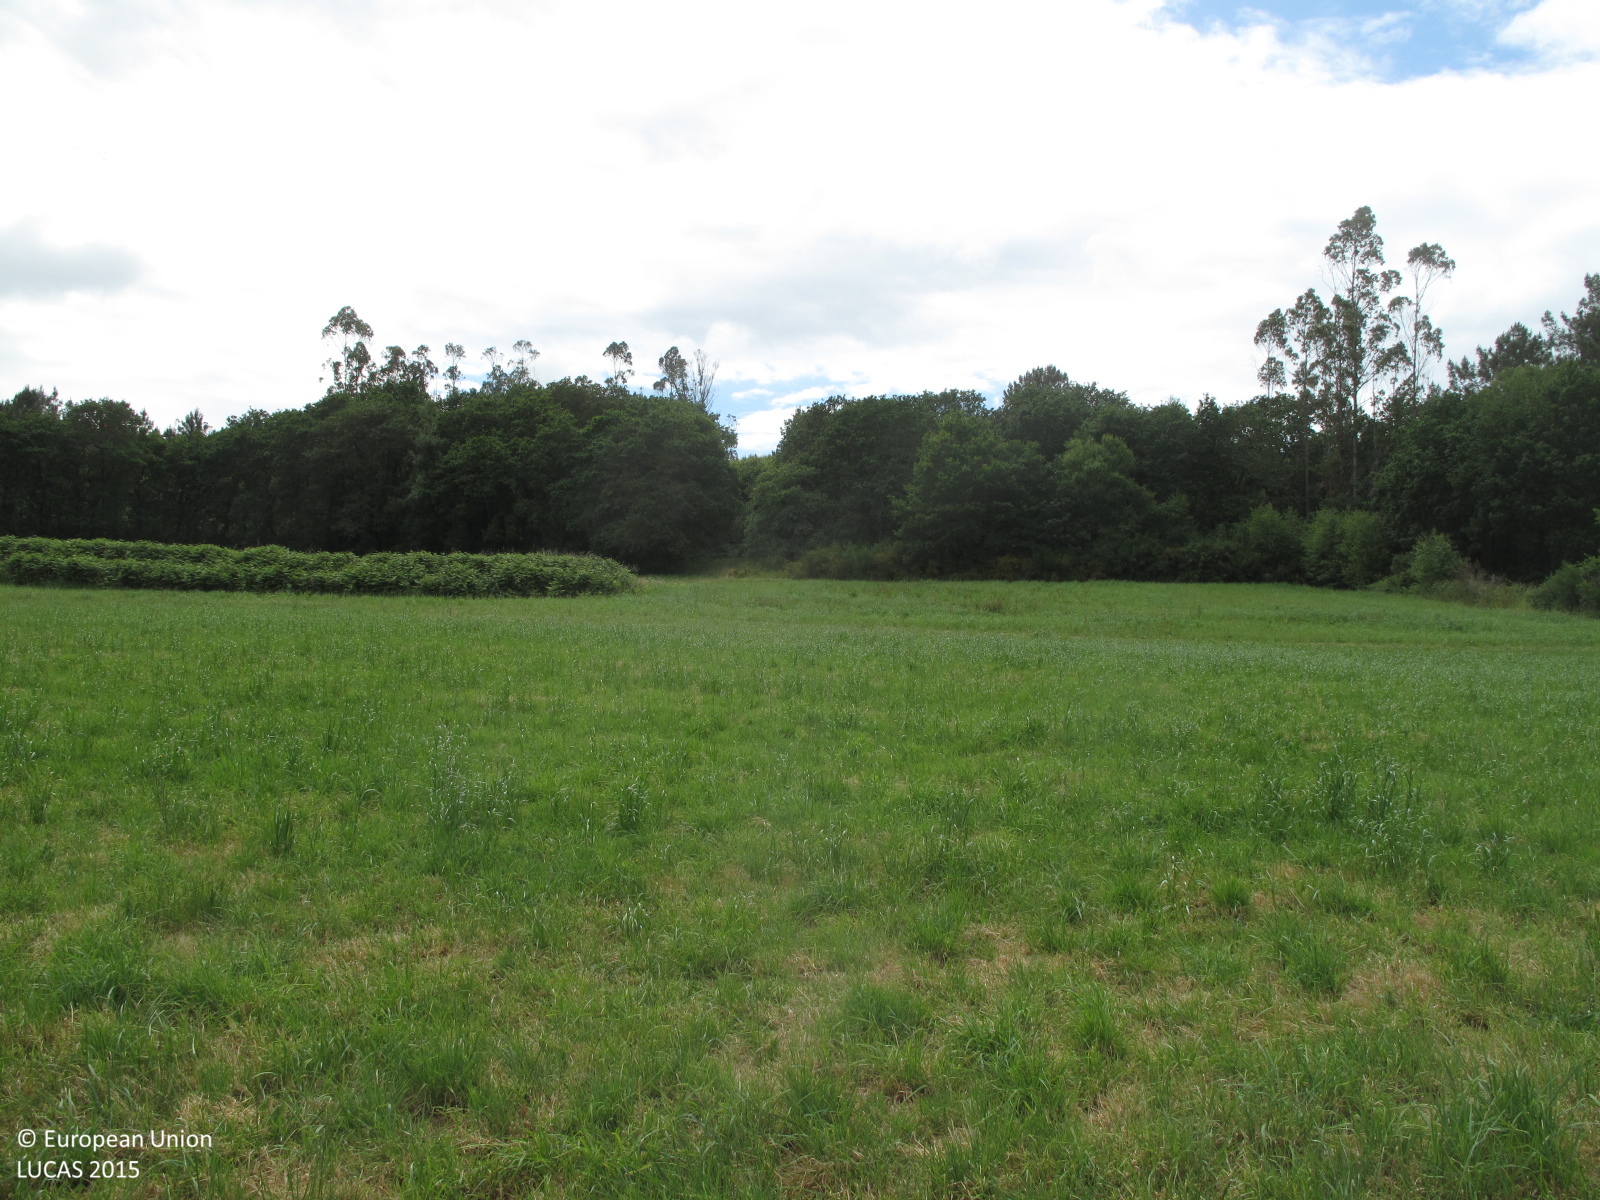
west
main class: Grassland
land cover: Grassland without tree/shrub cover
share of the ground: > 75 %
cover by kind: herbaceous plants 100 %
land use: Agriculture (excluding fallow land and kitchen gardens)
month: June
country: ES
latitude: 43.0288
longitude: -8.5526
